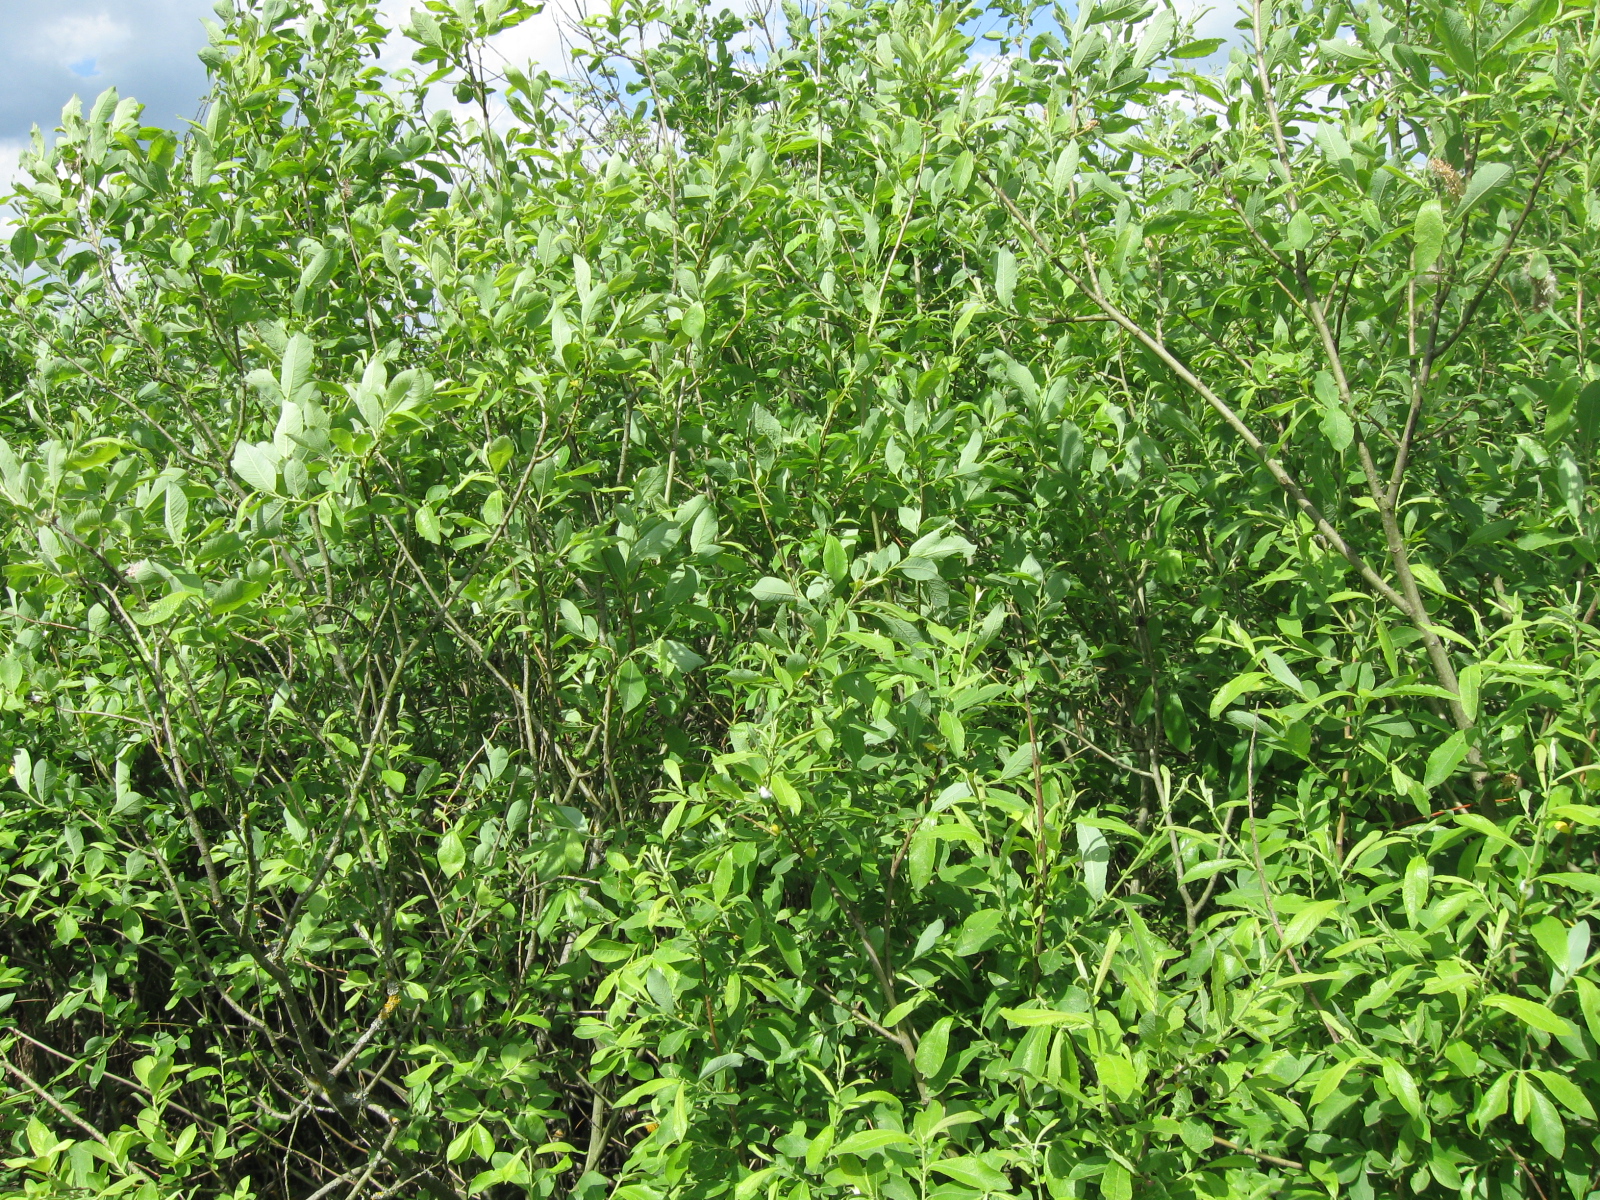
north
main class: Woodland
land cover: Broadleaved woodland
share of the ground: > 75 %
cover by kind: broadleaved forest trees 75 %, herbaceous plants 25 %
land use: Semi-natural and natural areas not in use
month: June
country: LT
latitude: 54.3244
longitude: 23.7876
